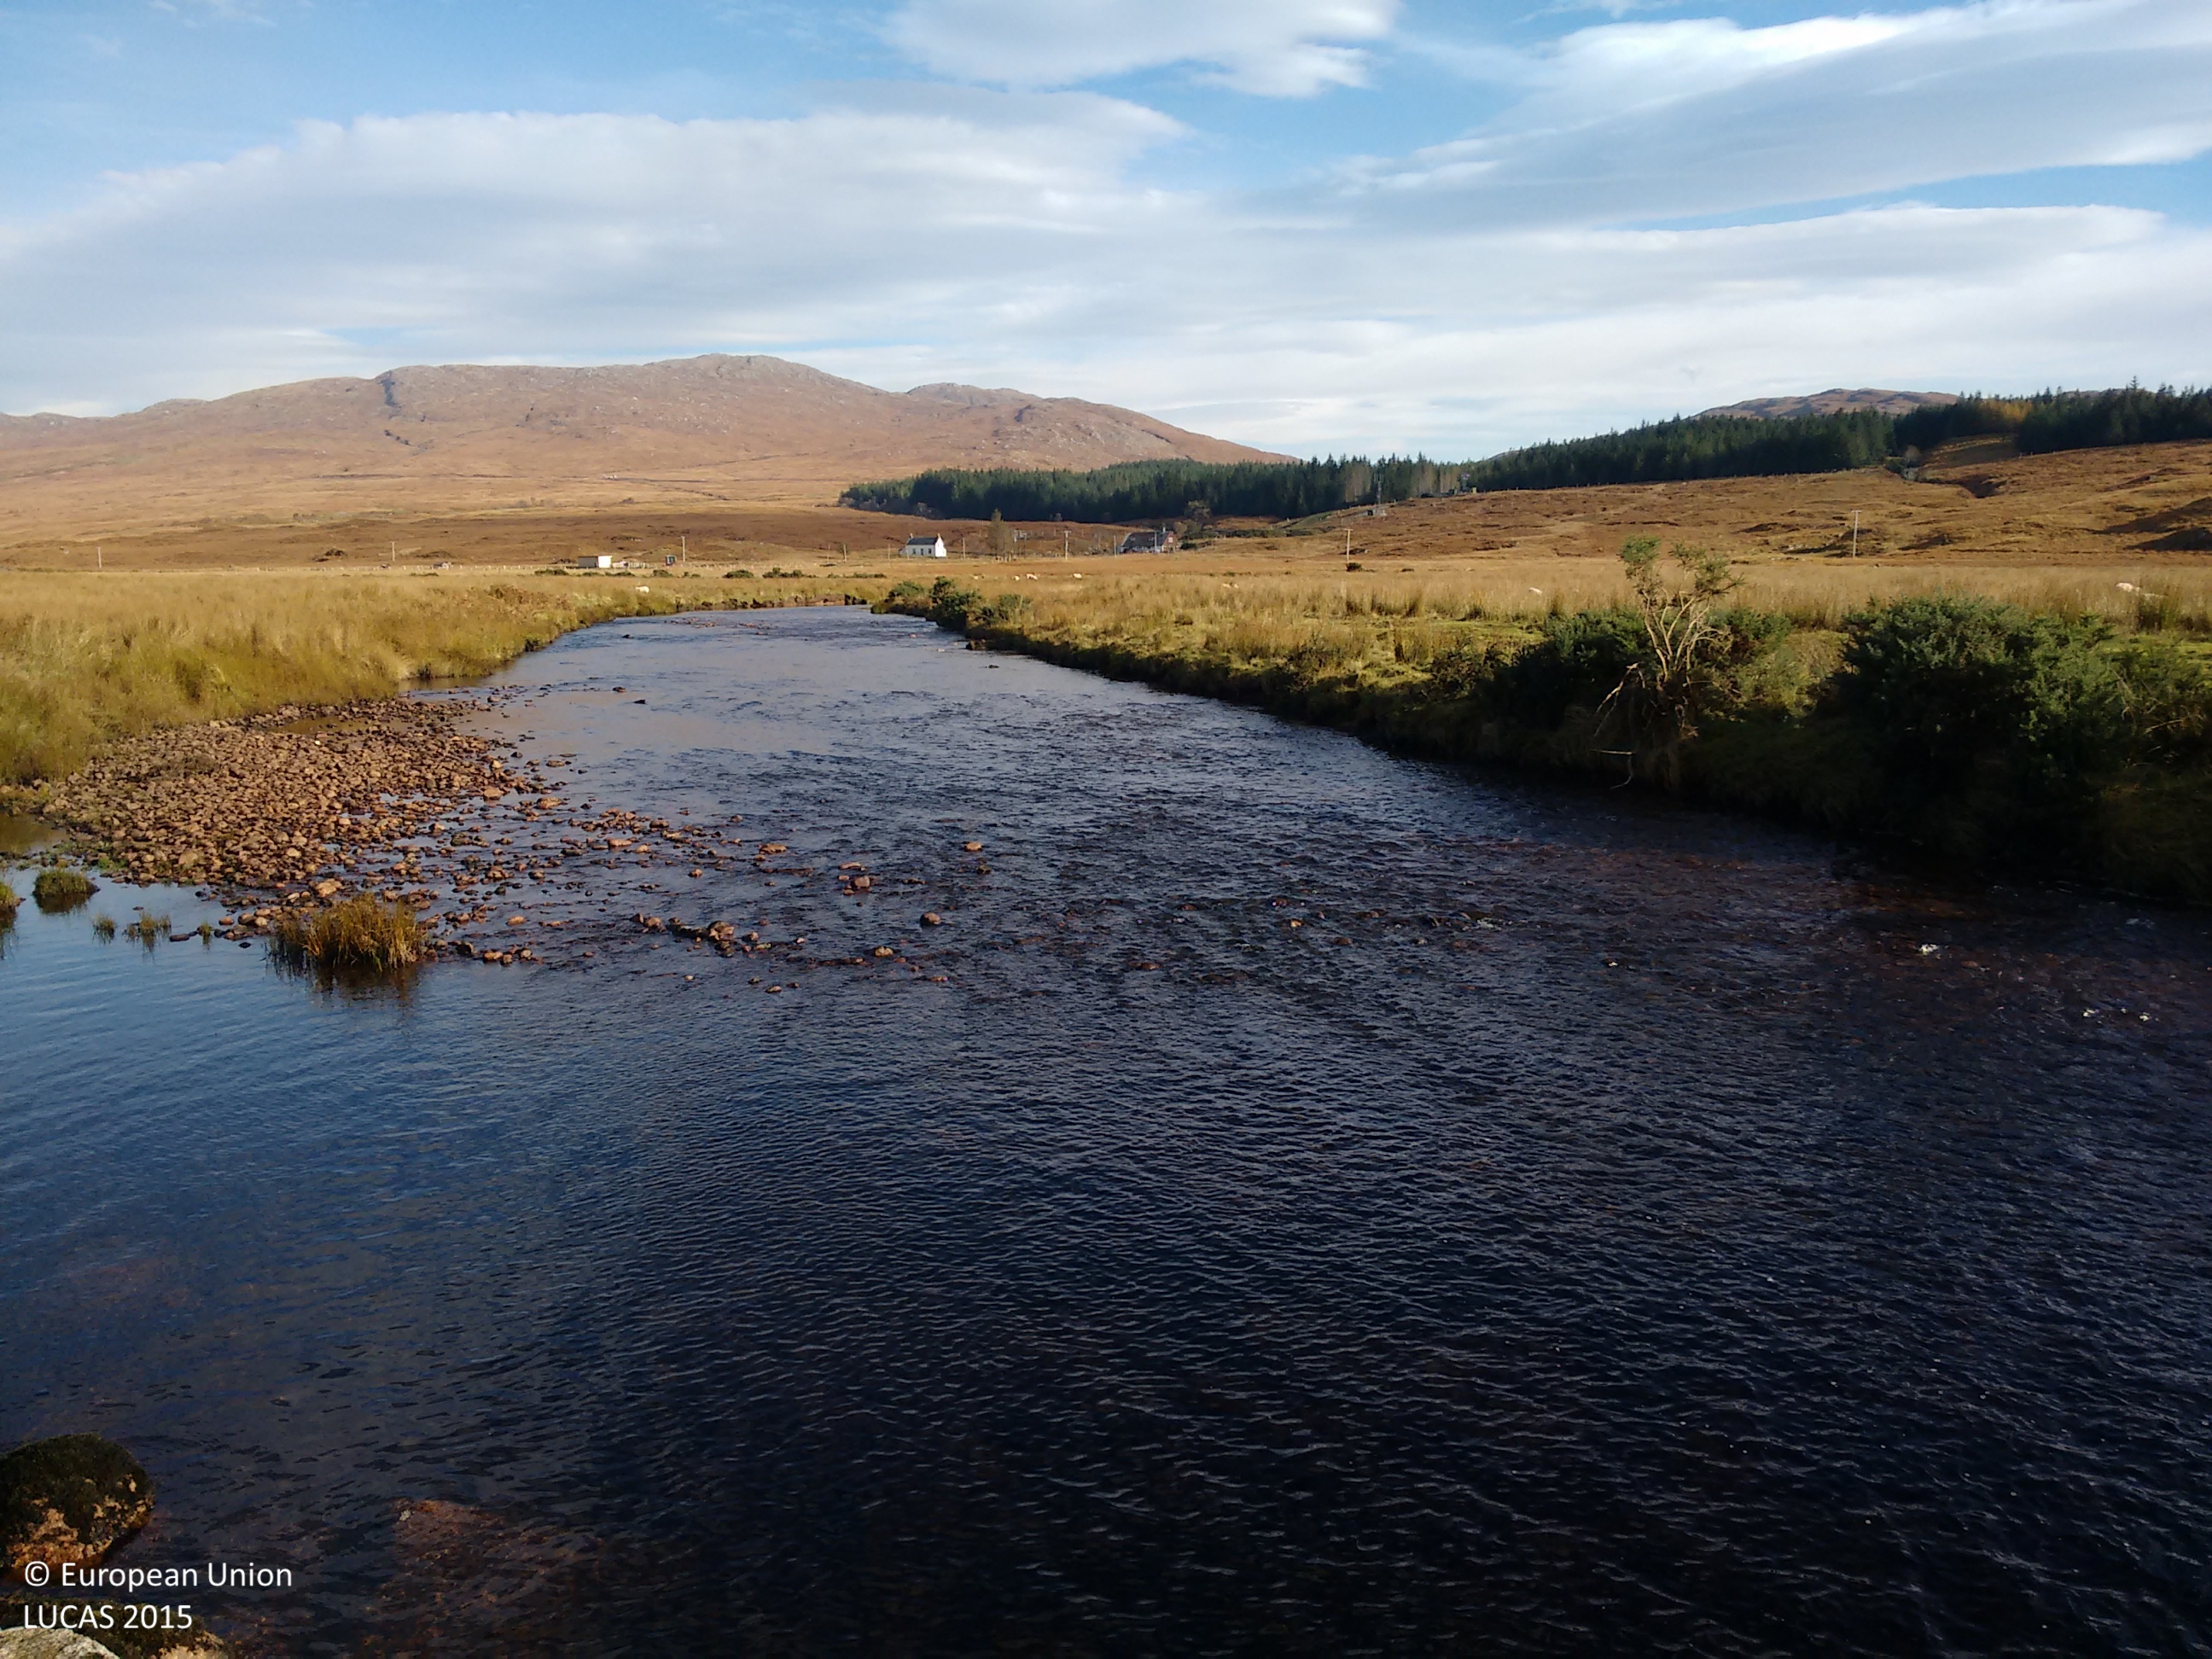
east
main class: Grassland
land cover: Grassland without tree/shrub cover
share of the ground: > 75 %
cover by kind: herbaceous plants 100 %
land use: Agriculture (excluding fallow land and kitchen gardens)
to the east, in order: Grassland without tree/shrub cover; Rivers and streams; Grassland without tree/shrub cover
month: October
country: GB
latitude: 56.5925
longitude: -5.6765
